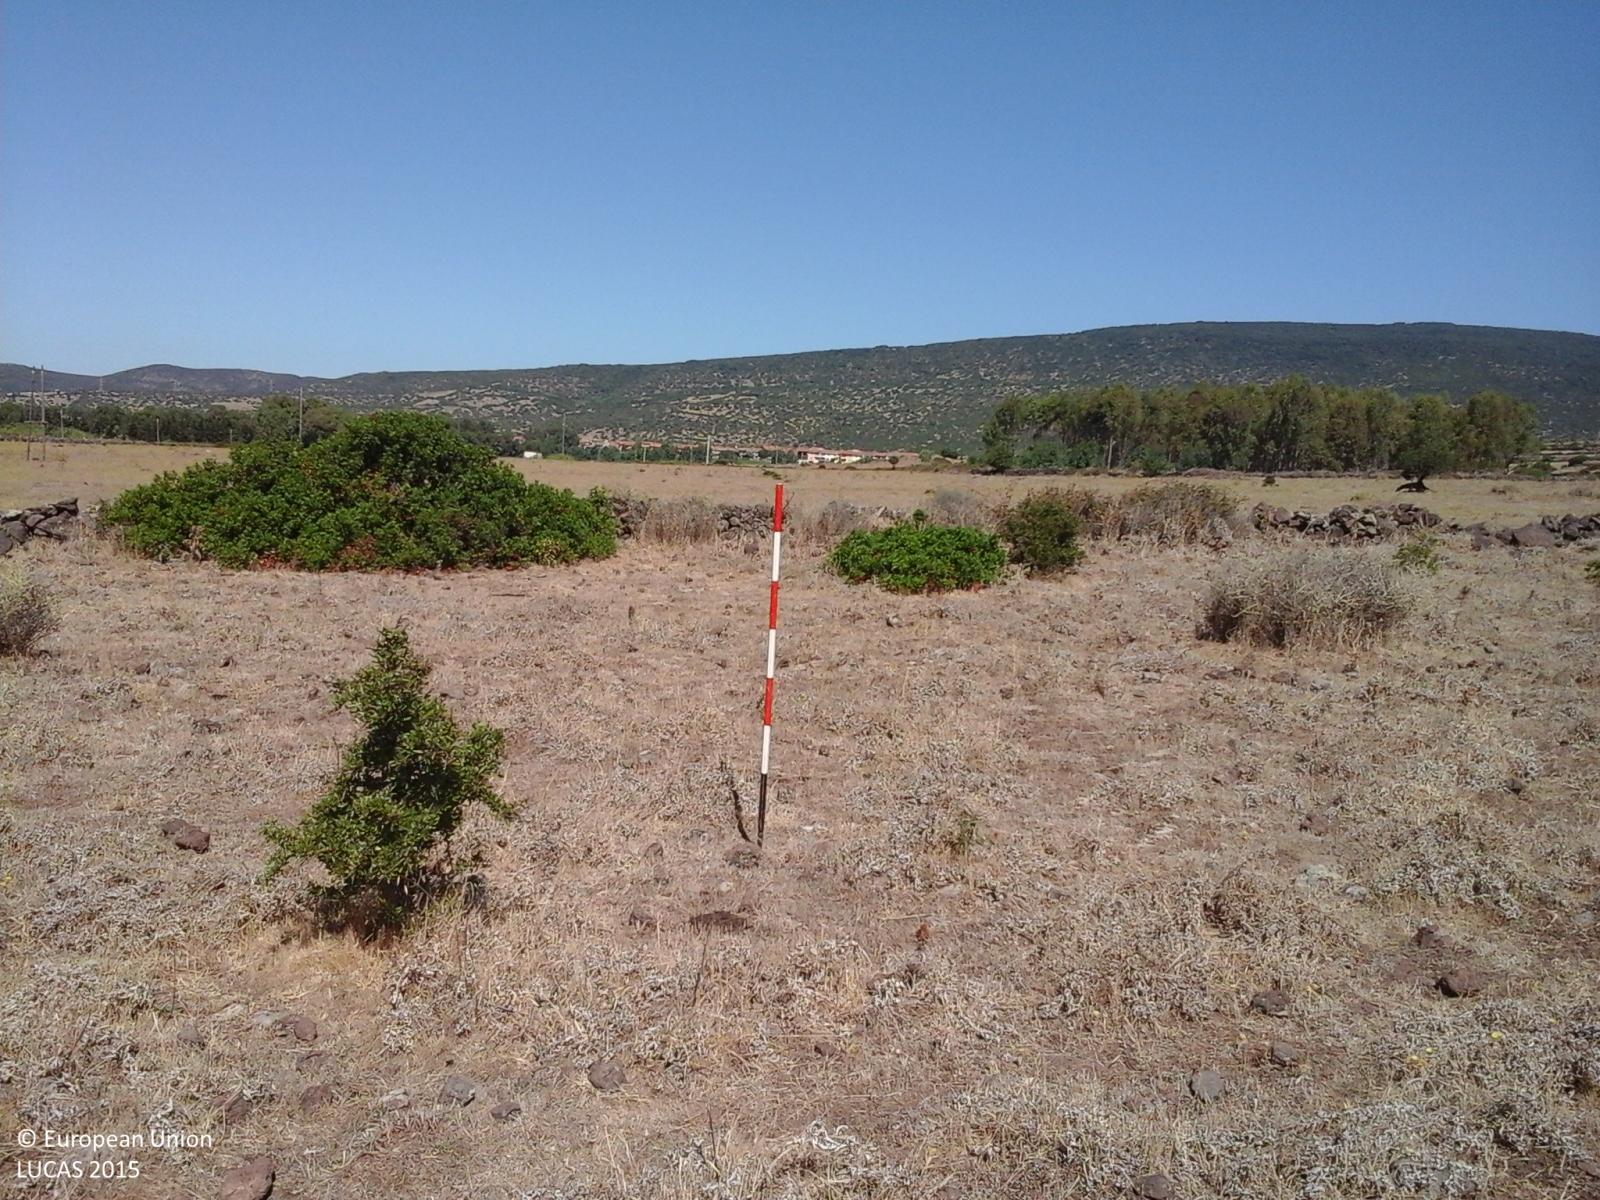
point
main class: Grassland
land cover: Grassland without tree/shrub cover
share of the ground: > 75 %
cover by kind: herbaceous plants 100 %
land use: Agriculture (excluding fallow land and kitchen gardens)
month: August
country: IT
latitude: 40.0399
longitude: 8.5895
